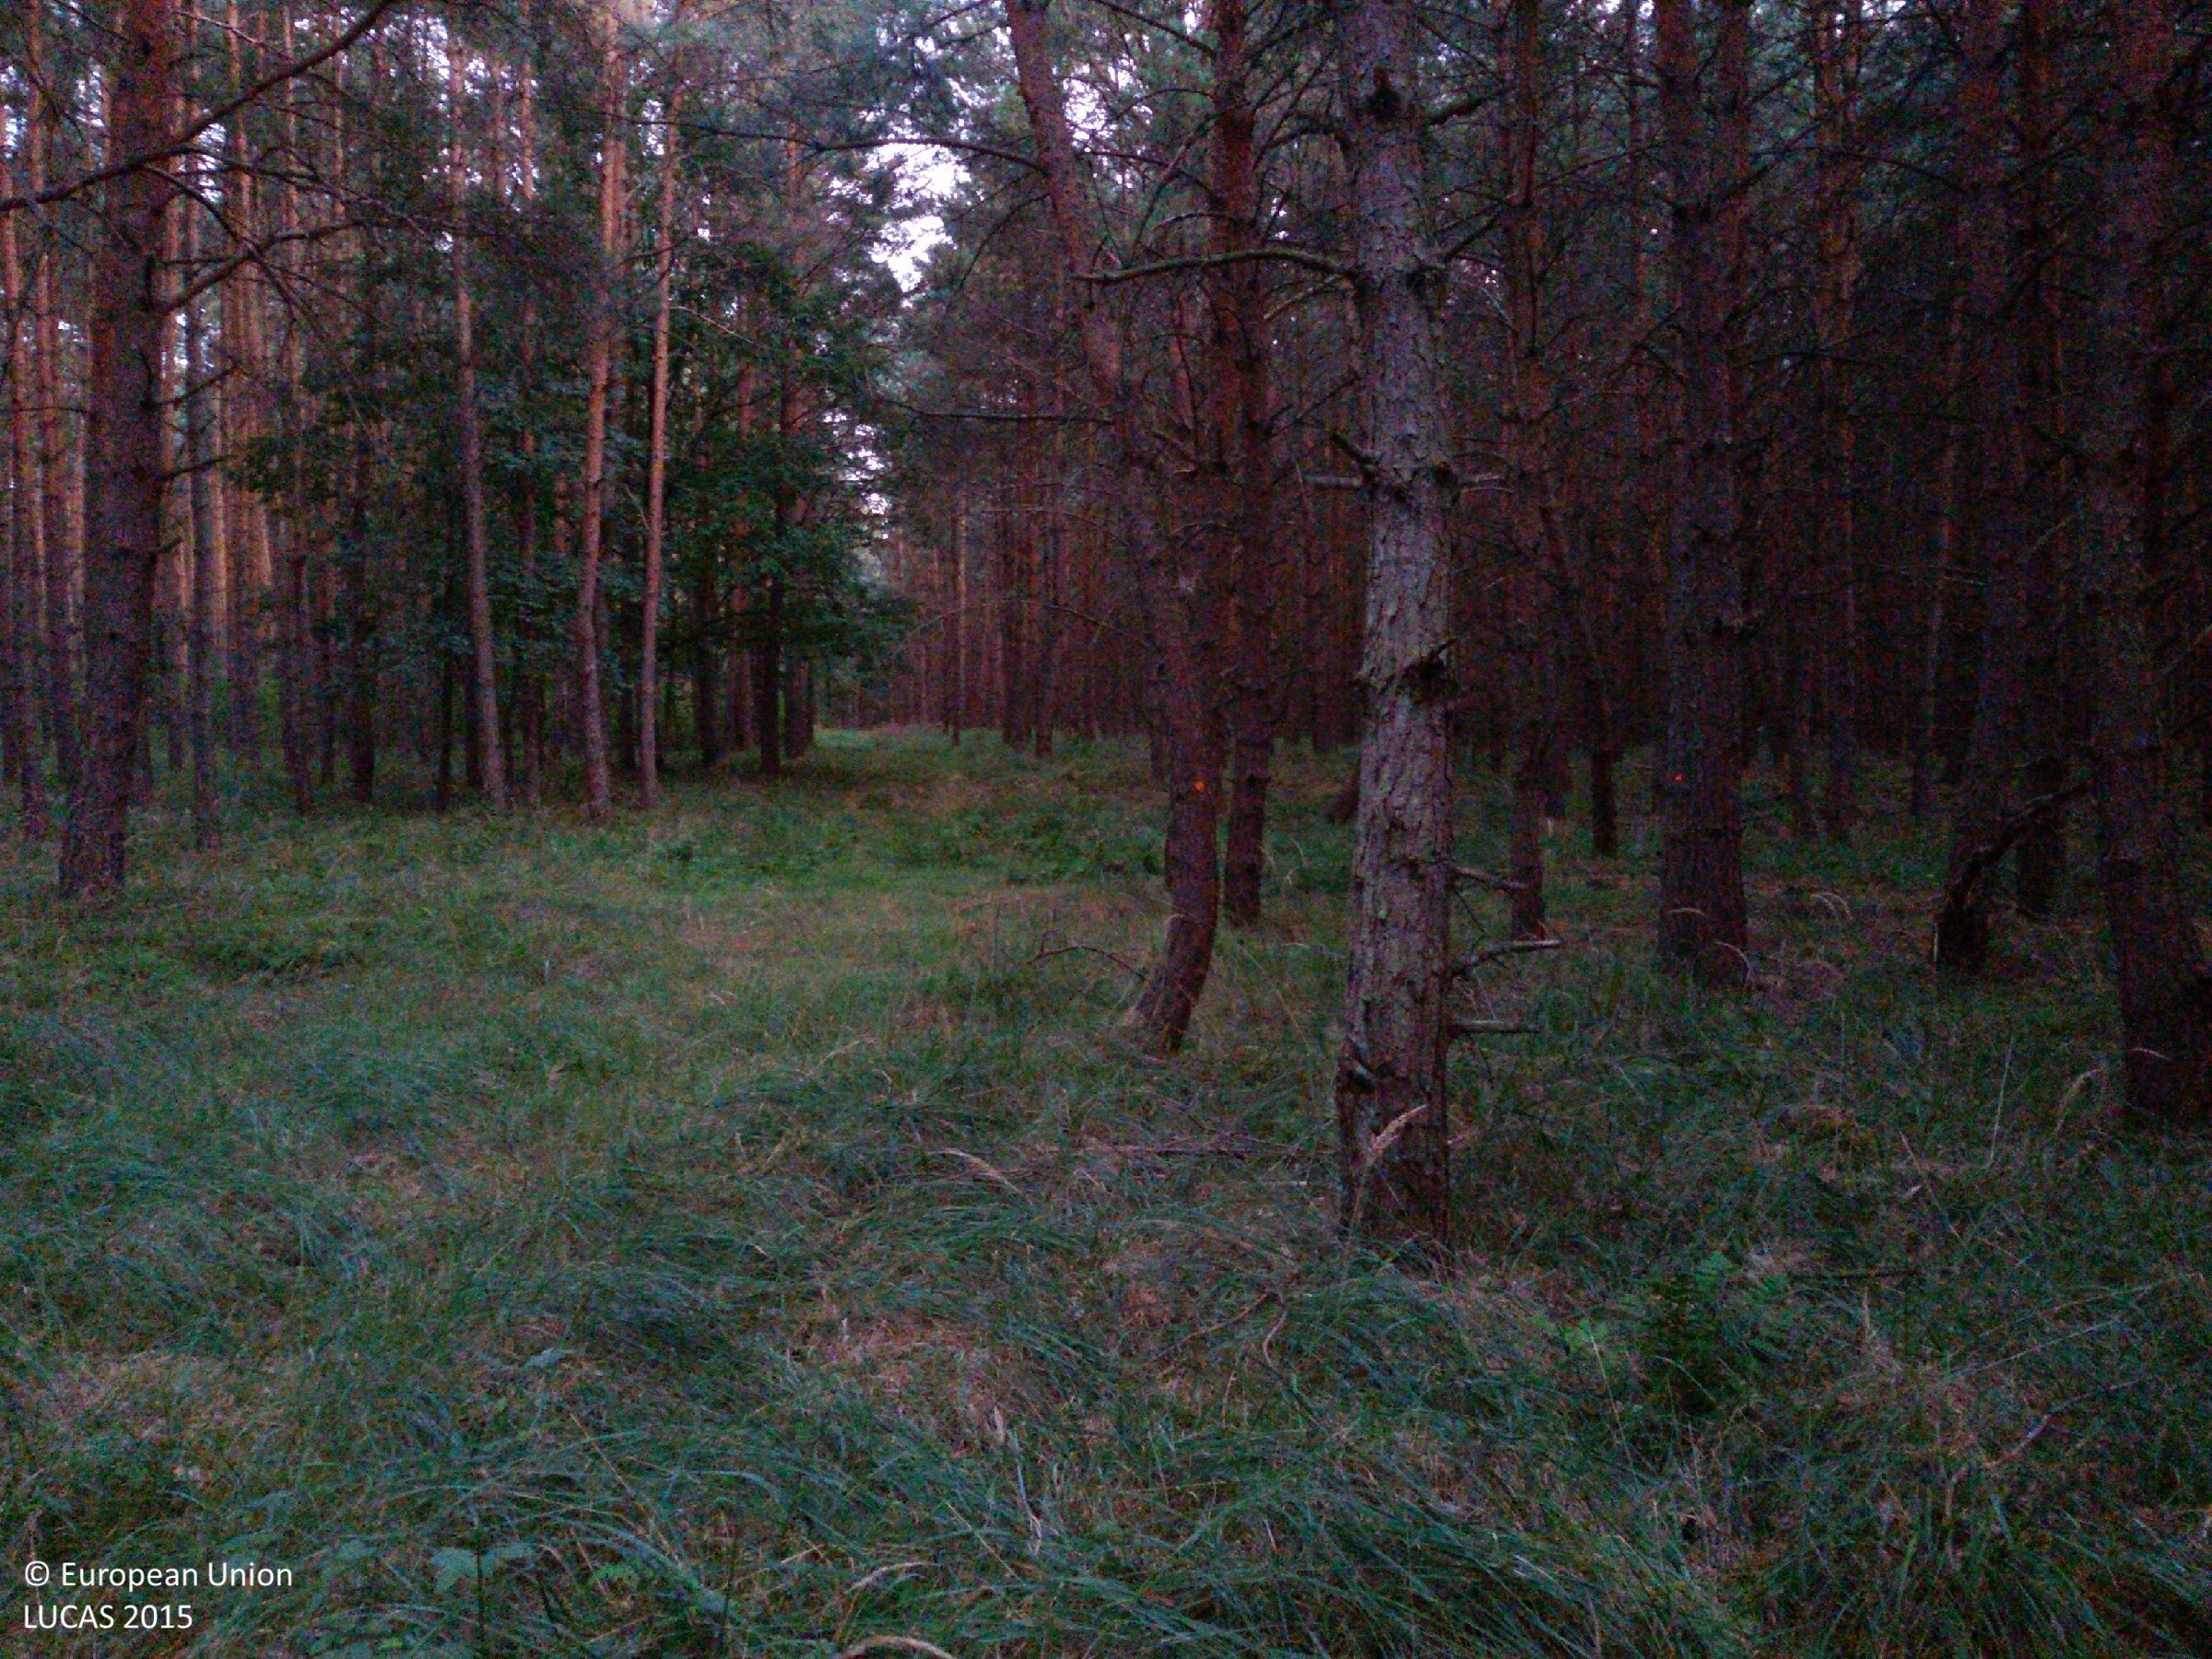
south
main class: Woodland
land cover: Pine dominated coniferous woodland
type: hemiboreal forest and nemoral coniferous forest and mixed broadleaved-coniferous forest
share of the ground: > 75 %
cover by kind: coniferous forest trees 80 %, herbaceous plants 20 %
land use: Forestry
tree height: > 5 m
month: September
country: PL
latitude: 52.3009
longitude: 14.7387
